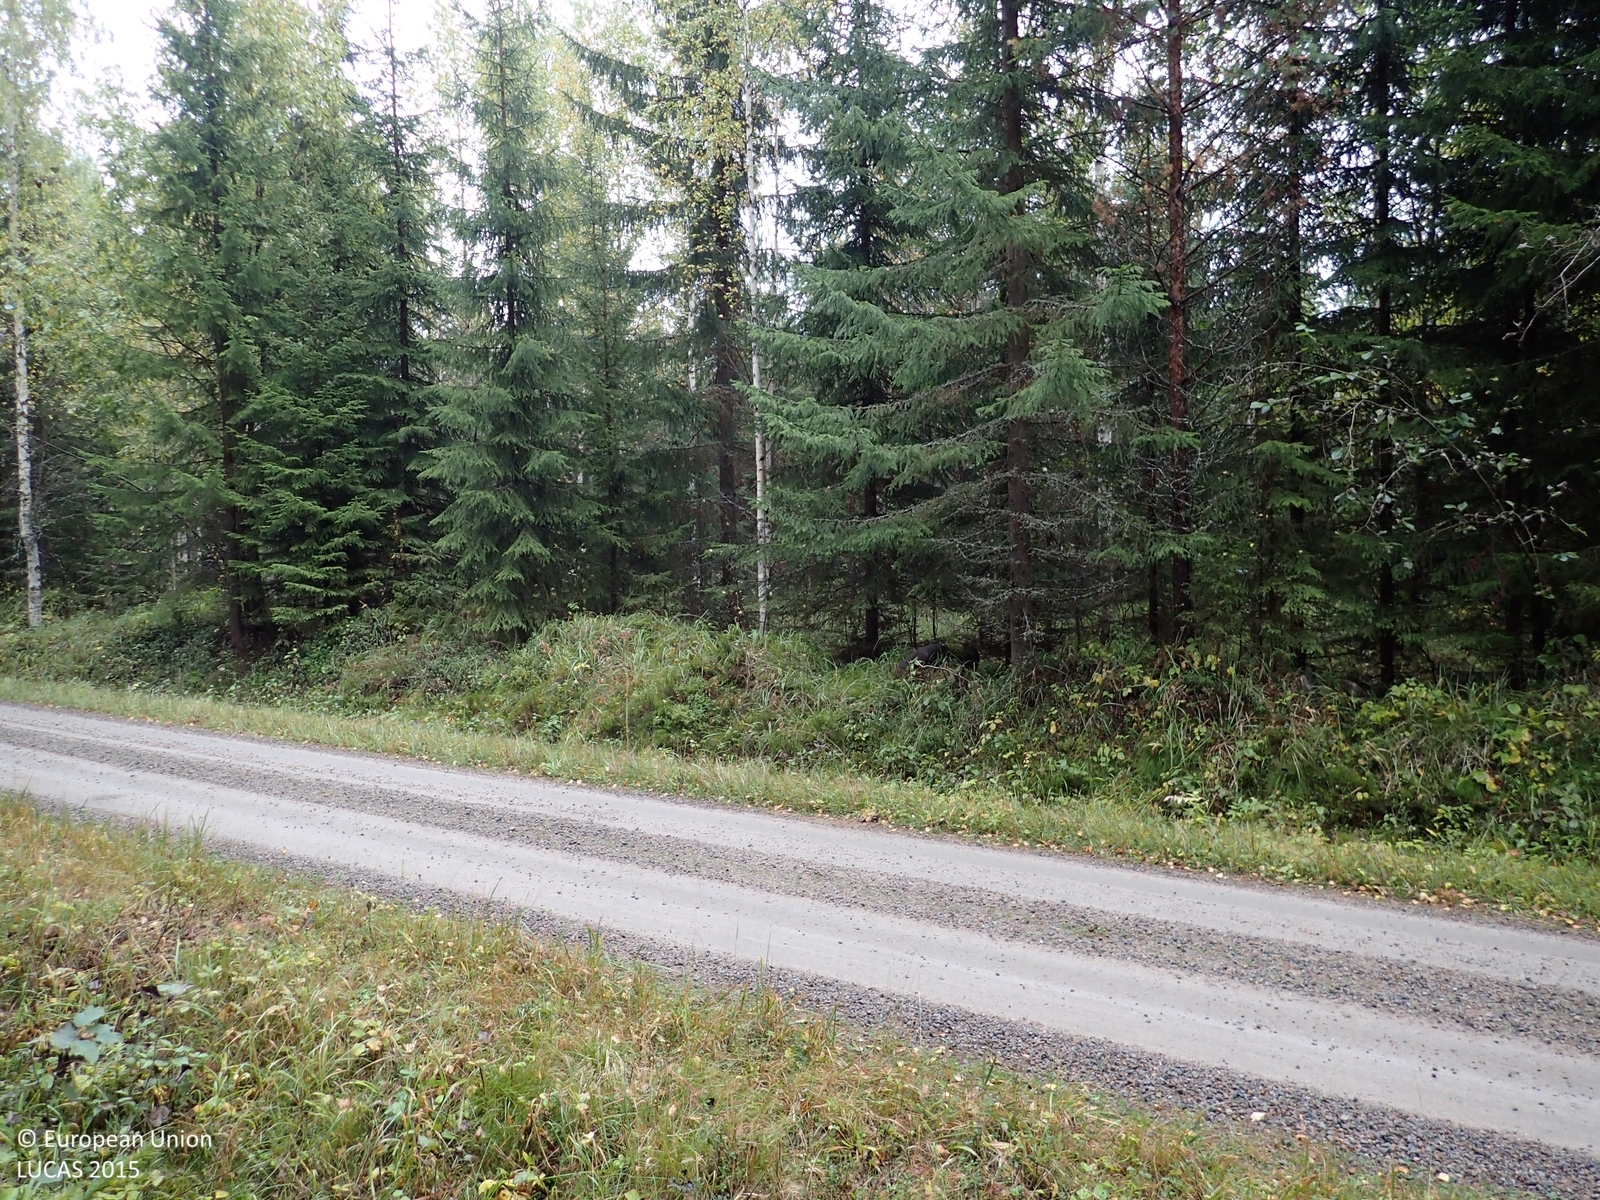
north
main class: Woodland
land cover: Other mixed woodland
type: boreal forest
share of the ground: > 75 %
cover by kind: coniferous forest trees 60 %, broadleaved forest trees 20 %, shrubs 10 %, herbaceous plants 10 %
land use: Forestry
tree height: > 5 m
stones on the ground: < 10 %
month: September
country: FI
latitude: 63.2226
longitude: 25.6868
